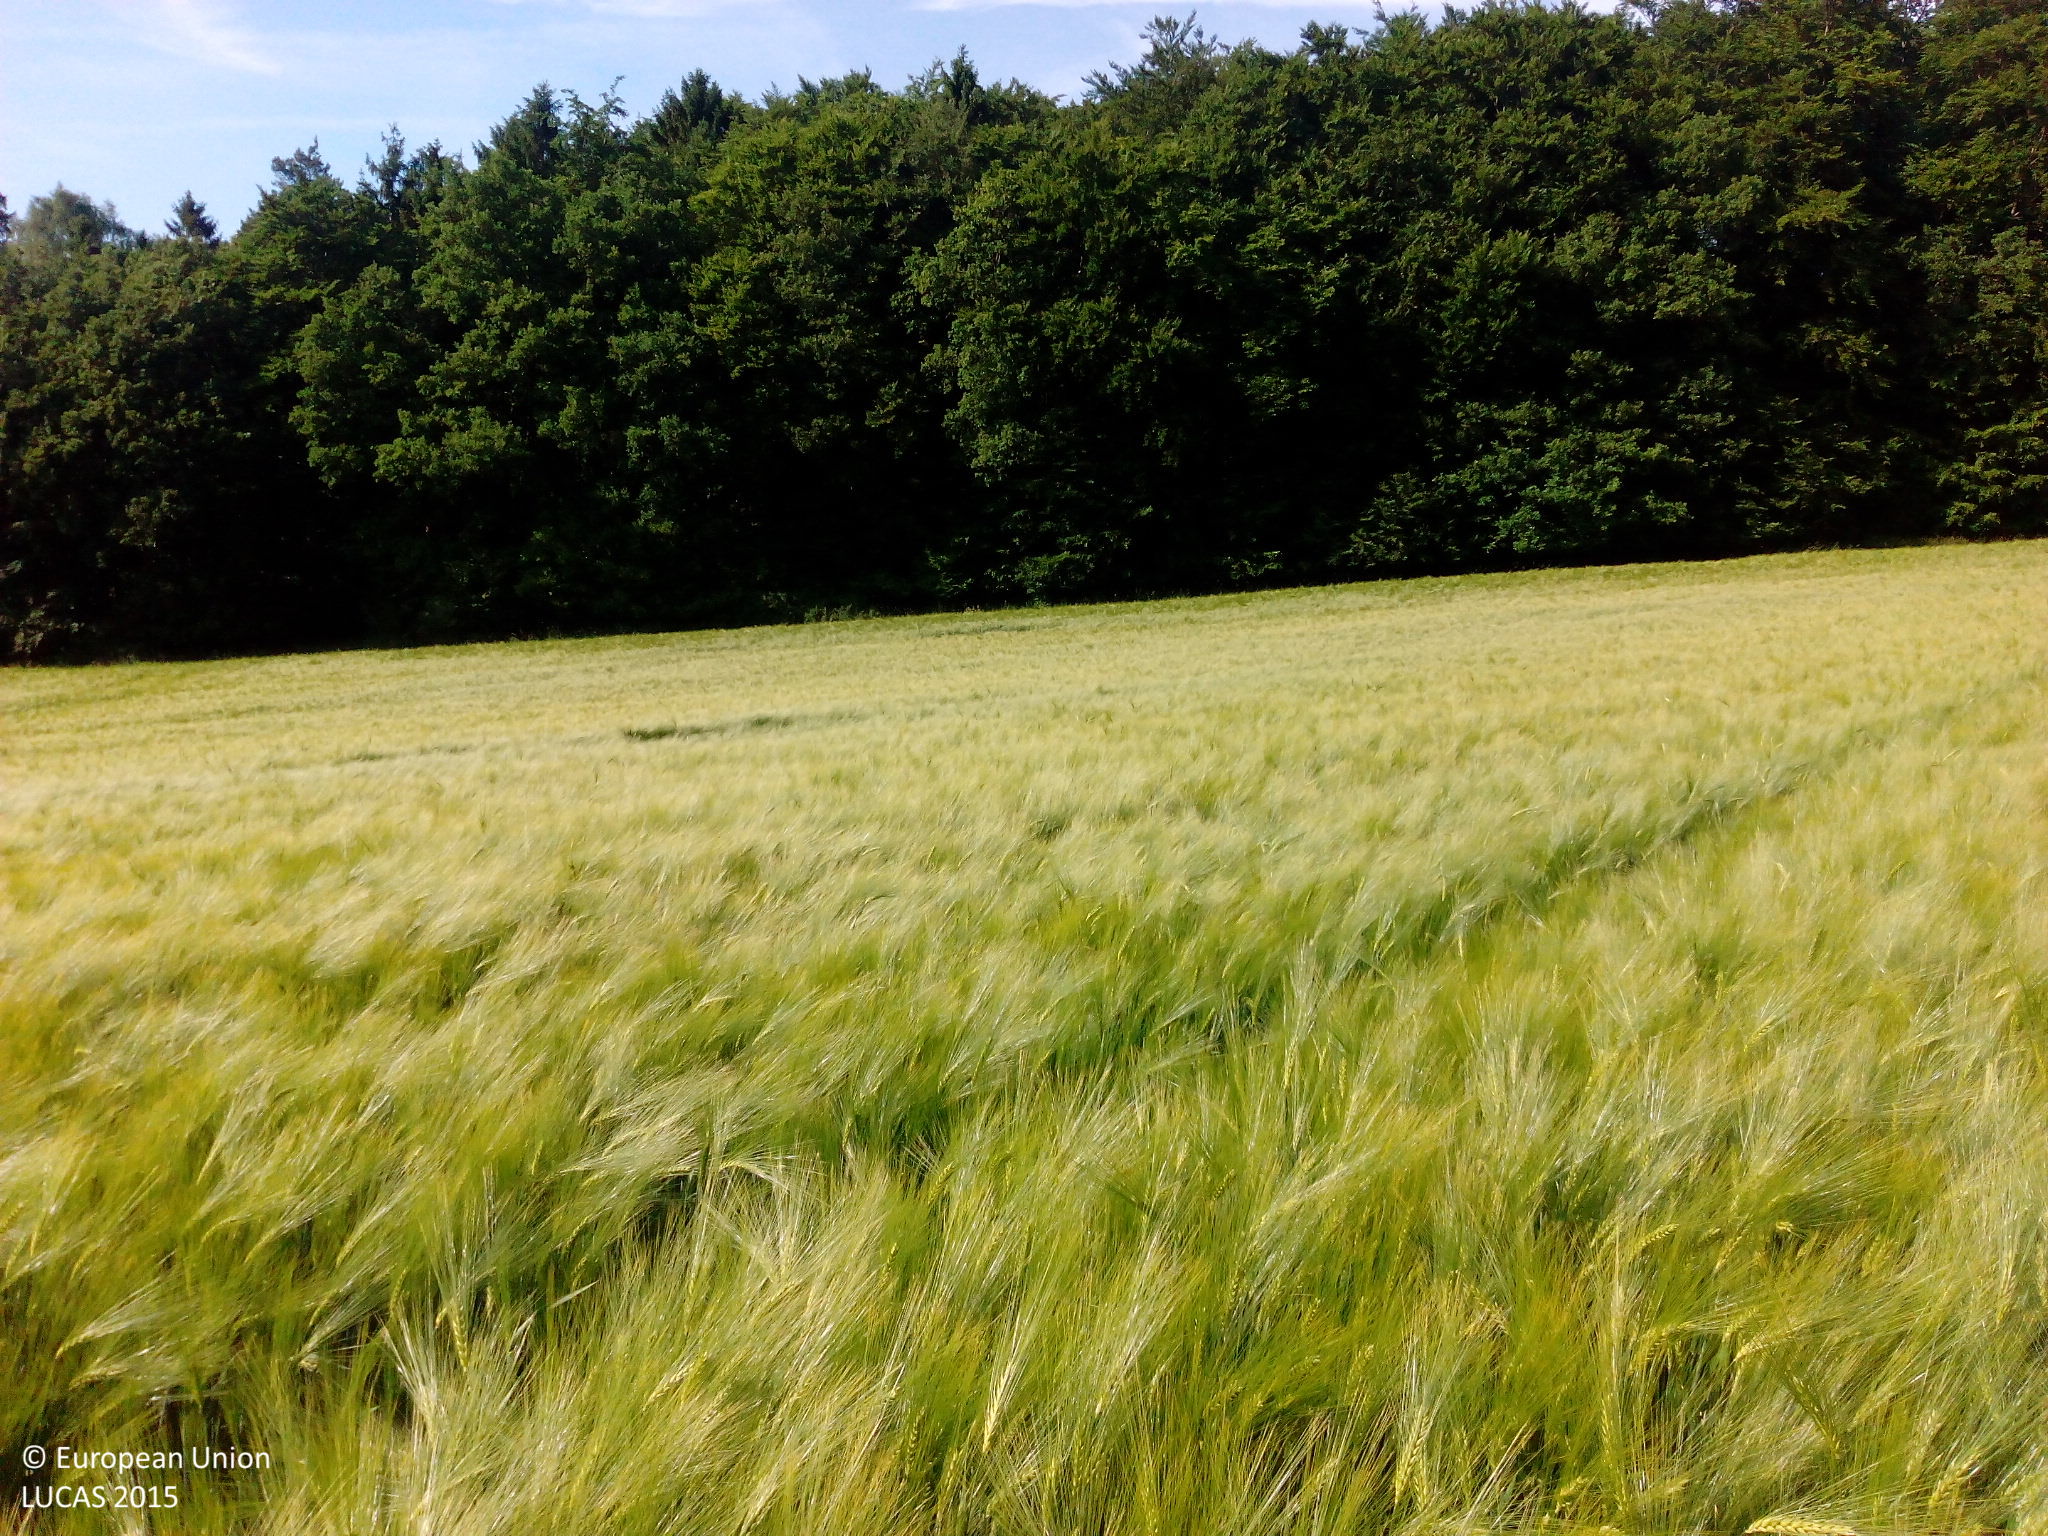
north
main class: Cropland
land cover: Barley
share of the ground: > 75 %
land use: Agriculture (excluding fallow land and kitchen gardens)
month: June
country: DE
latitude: 50.1686
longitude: 8.1104
